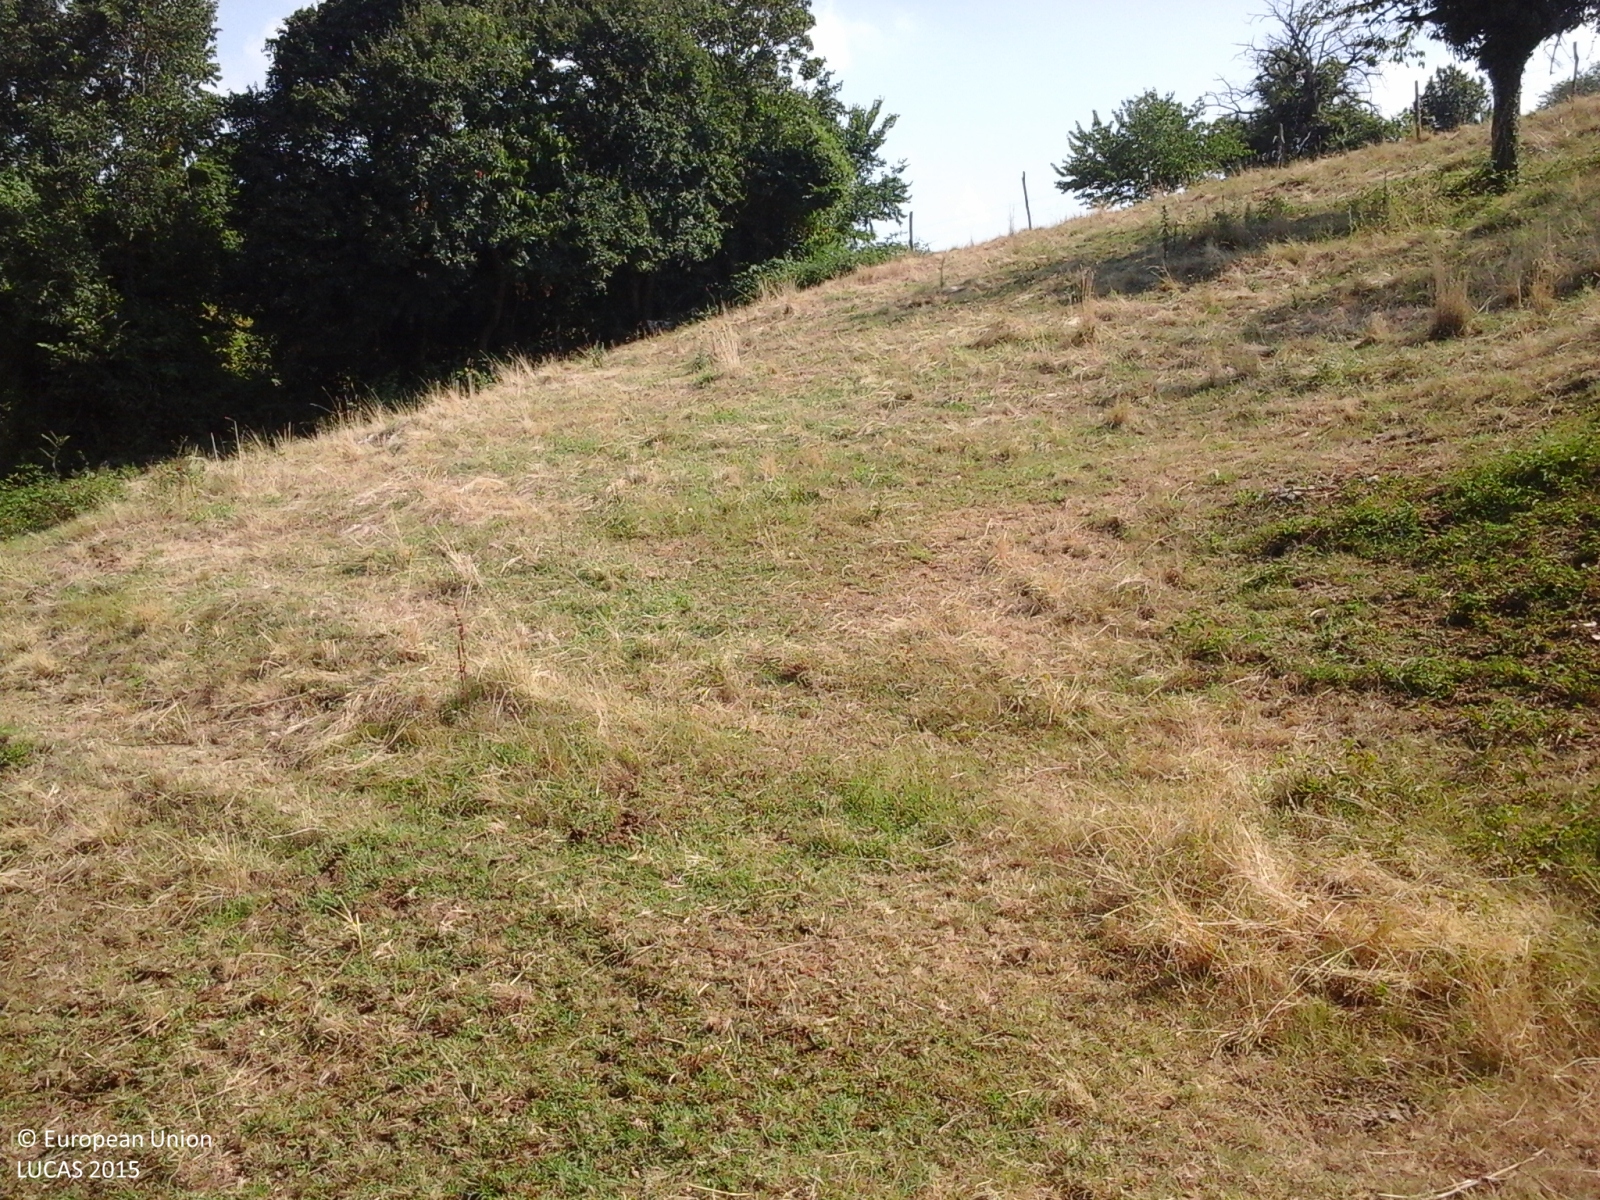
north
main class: Grassland
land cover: Grassland without tree/shrub cover
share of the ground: > 75 %
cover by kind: herbaceous plants 100 %
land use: Agriculture (excluding fallow land and kitchen gardens)
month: July
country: IT
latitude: 45.5346
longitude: 11.1122
